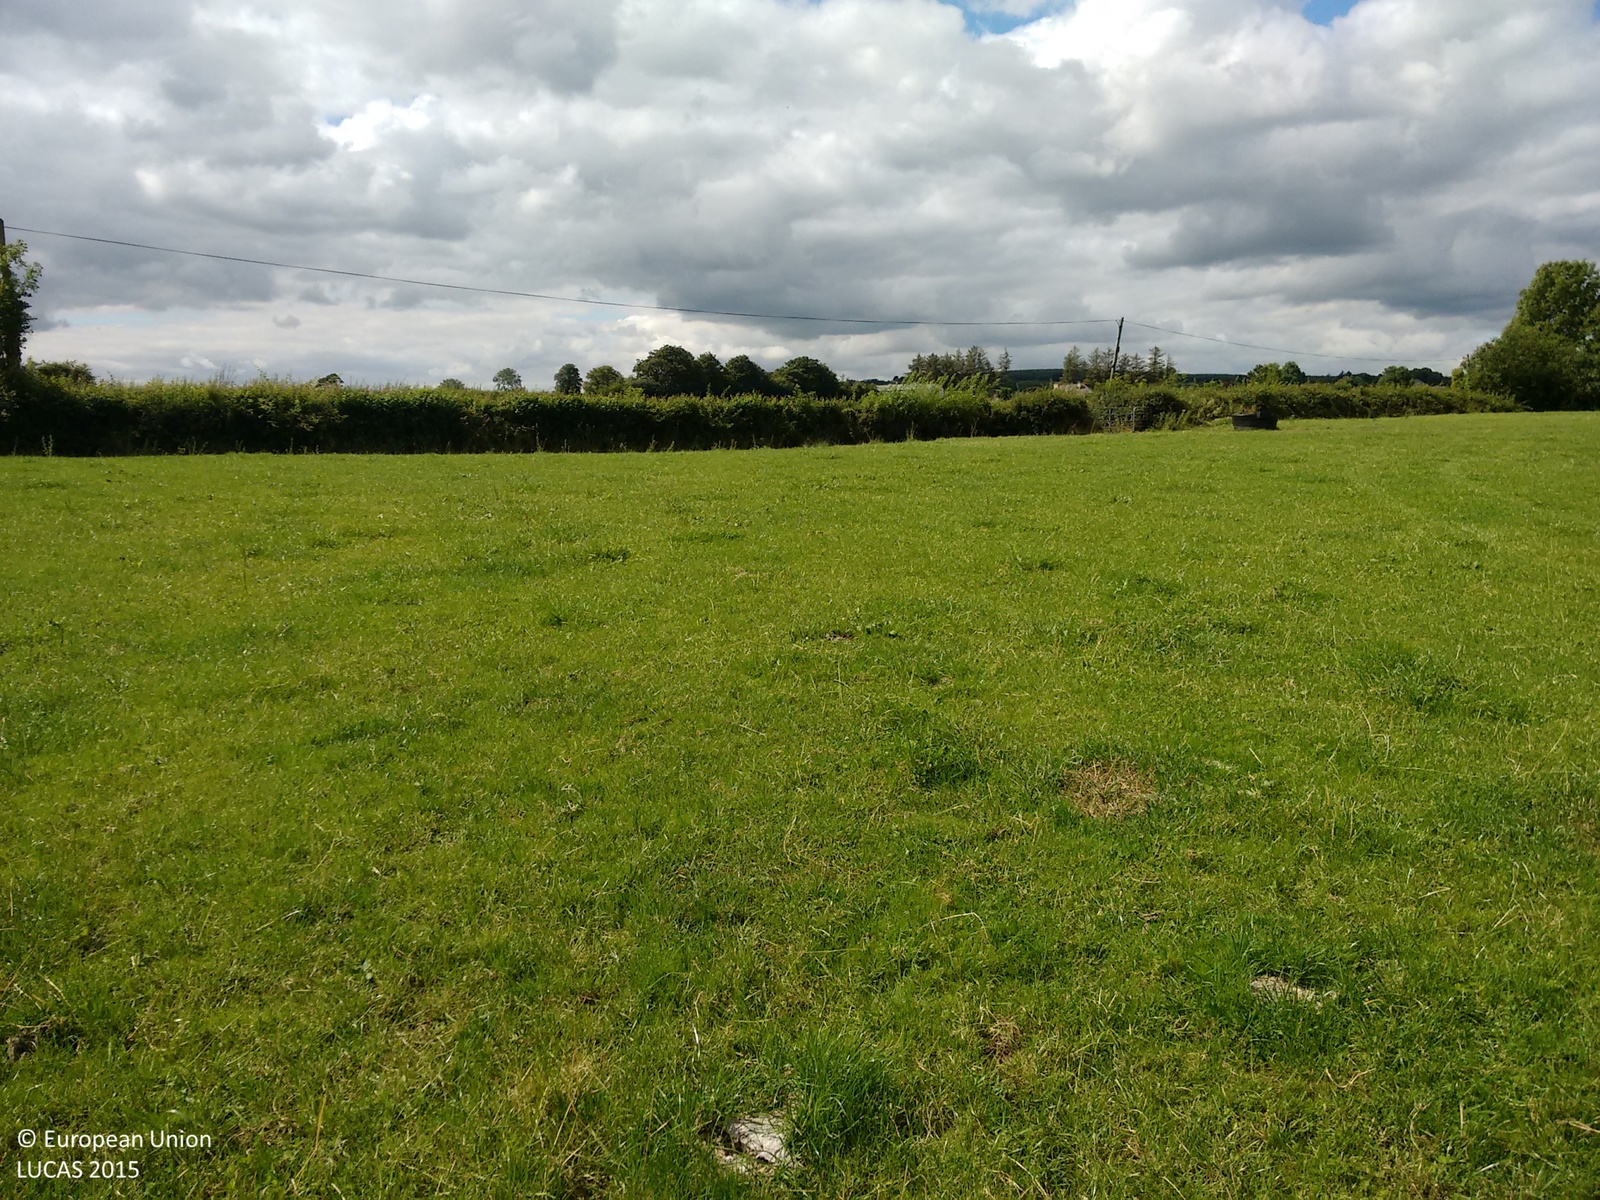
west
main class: Grassland
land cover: Grassland without tree/shrub cover
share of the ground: > 75 %
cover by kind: herbaceous plants 100 %
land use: Agriculture (excluding fallow land and kitchen gardens)
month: August
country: IE
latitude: 52.8906
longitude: -7.8424
